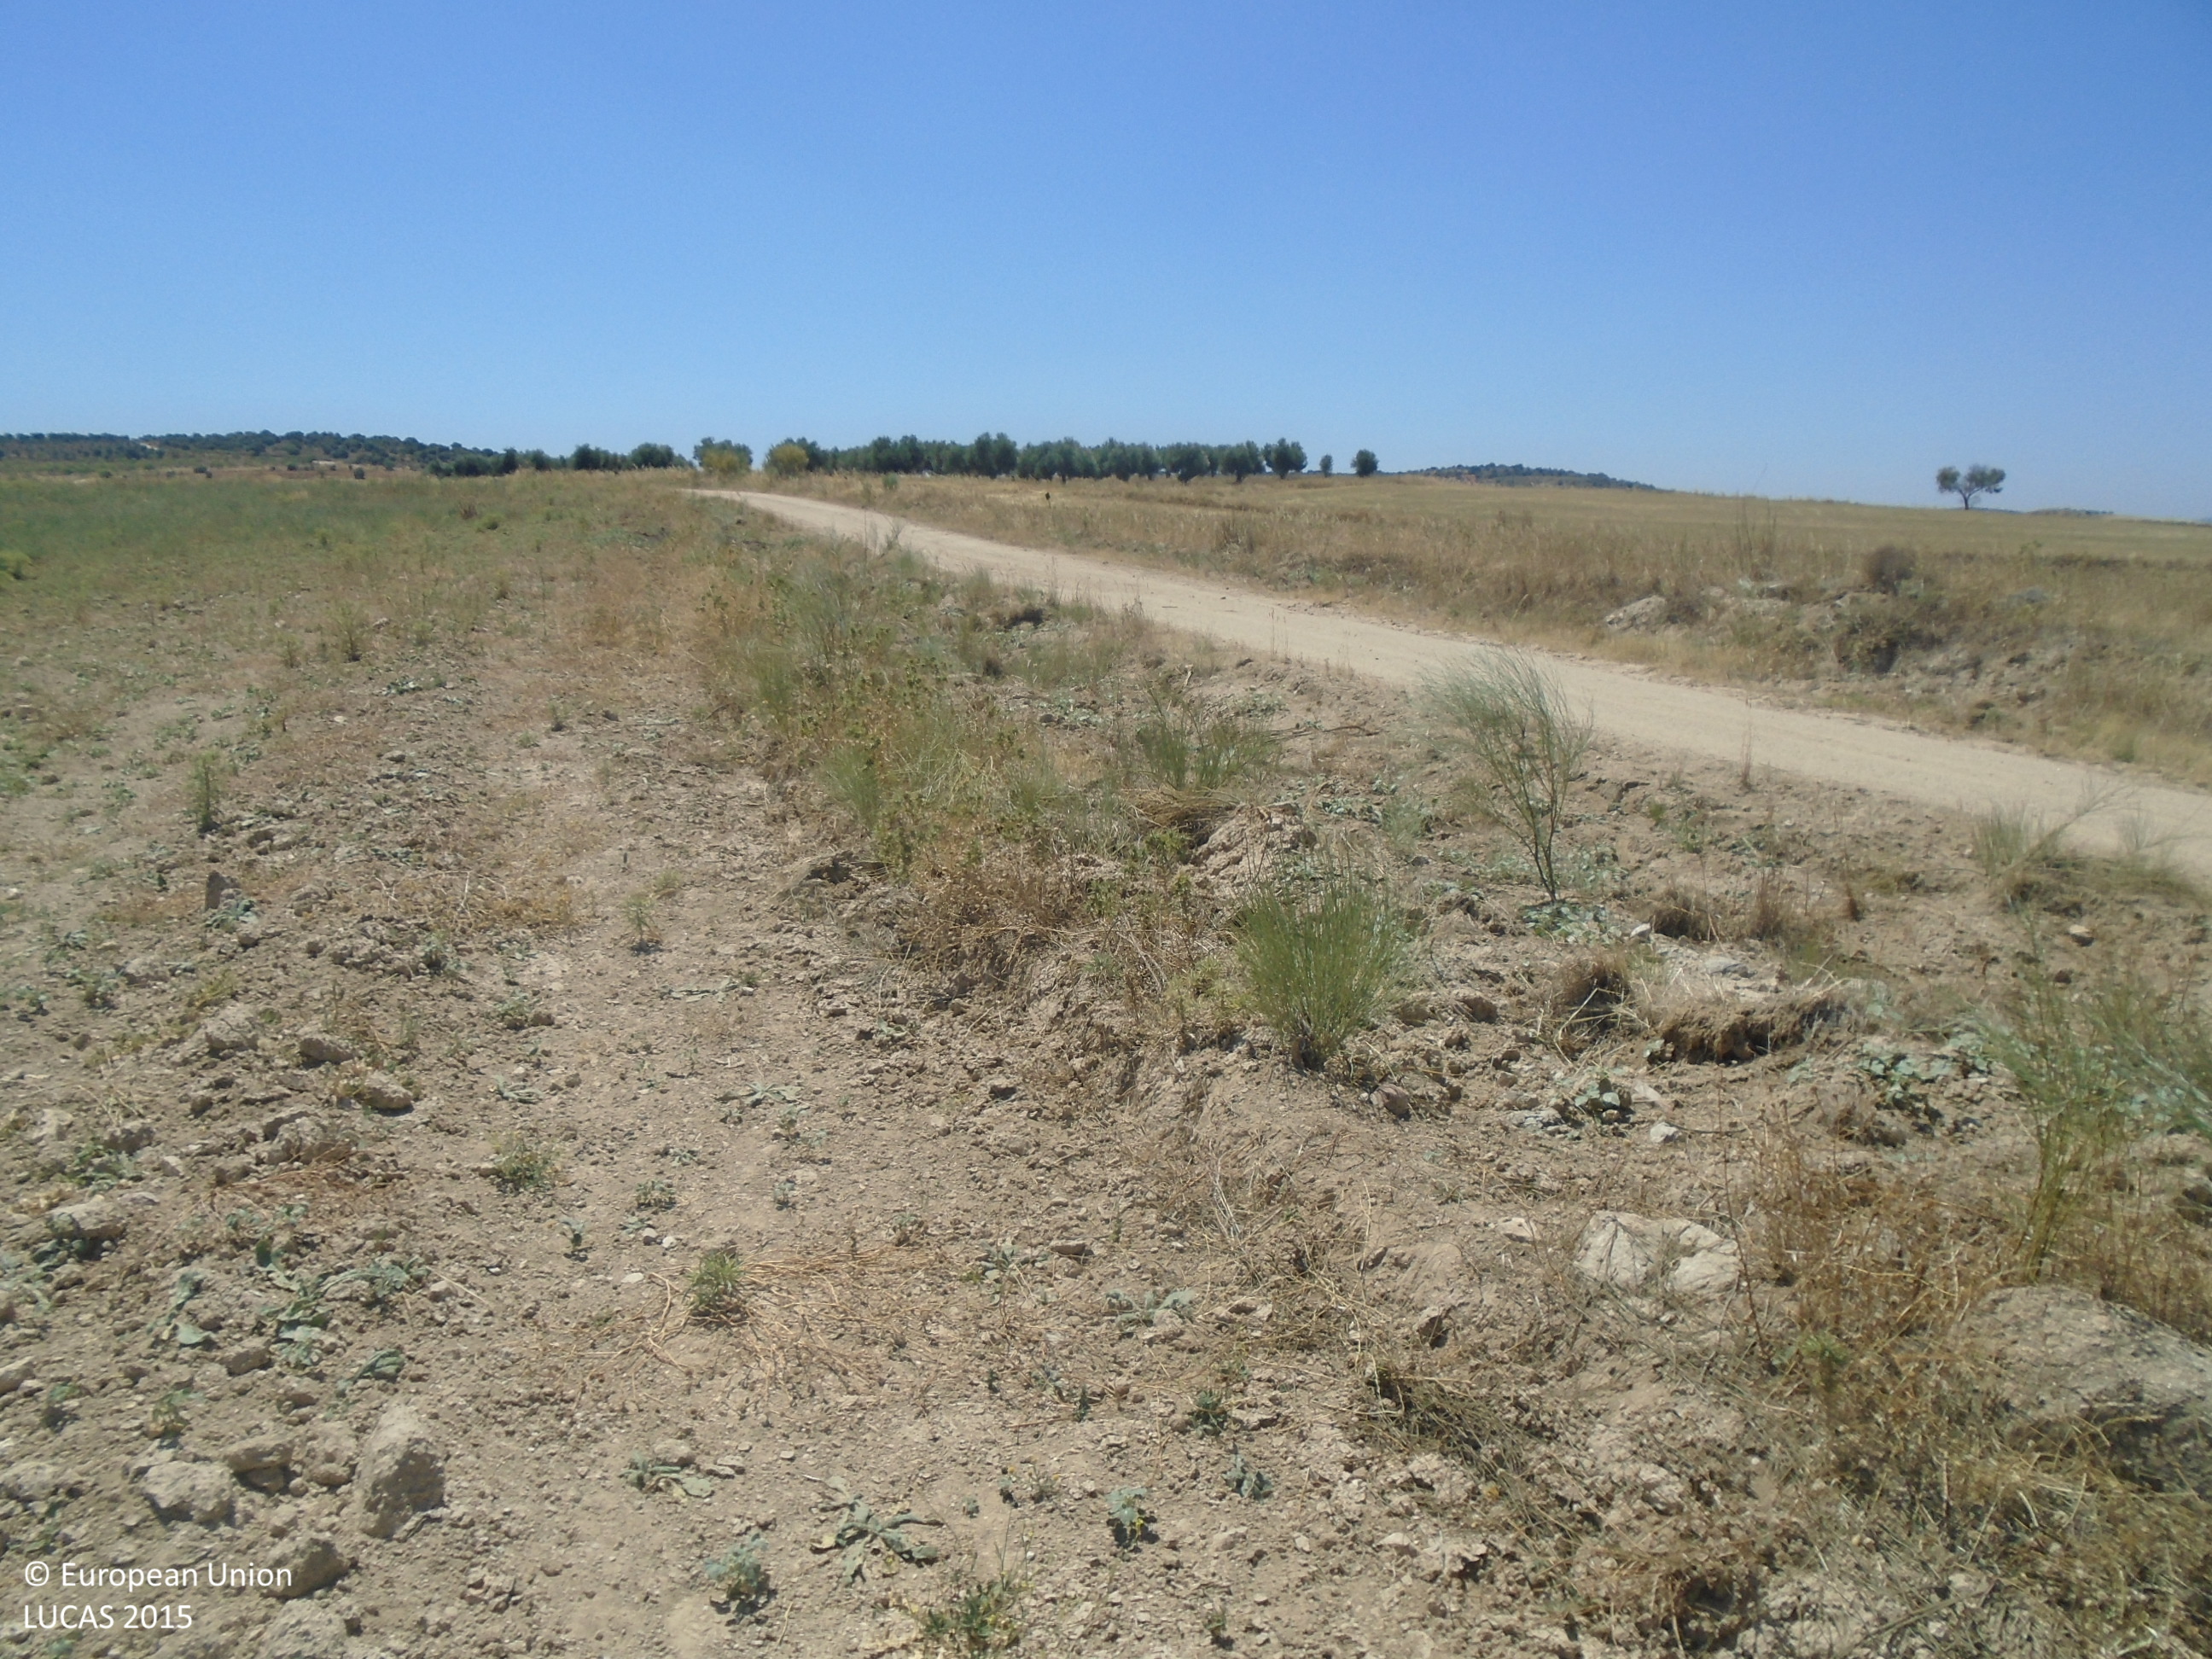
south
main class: Grassland
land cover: Spontaneously vegetated surfaces
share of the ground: > 75 %
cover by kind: herbaceous plants 90 %, unconsolidated bare surface 10 %
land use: Agriculture (excluding fallow land and kitchen gardens)
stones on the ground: < 10 %
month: July
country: ES
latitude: 39.7500
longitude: -4.9977
